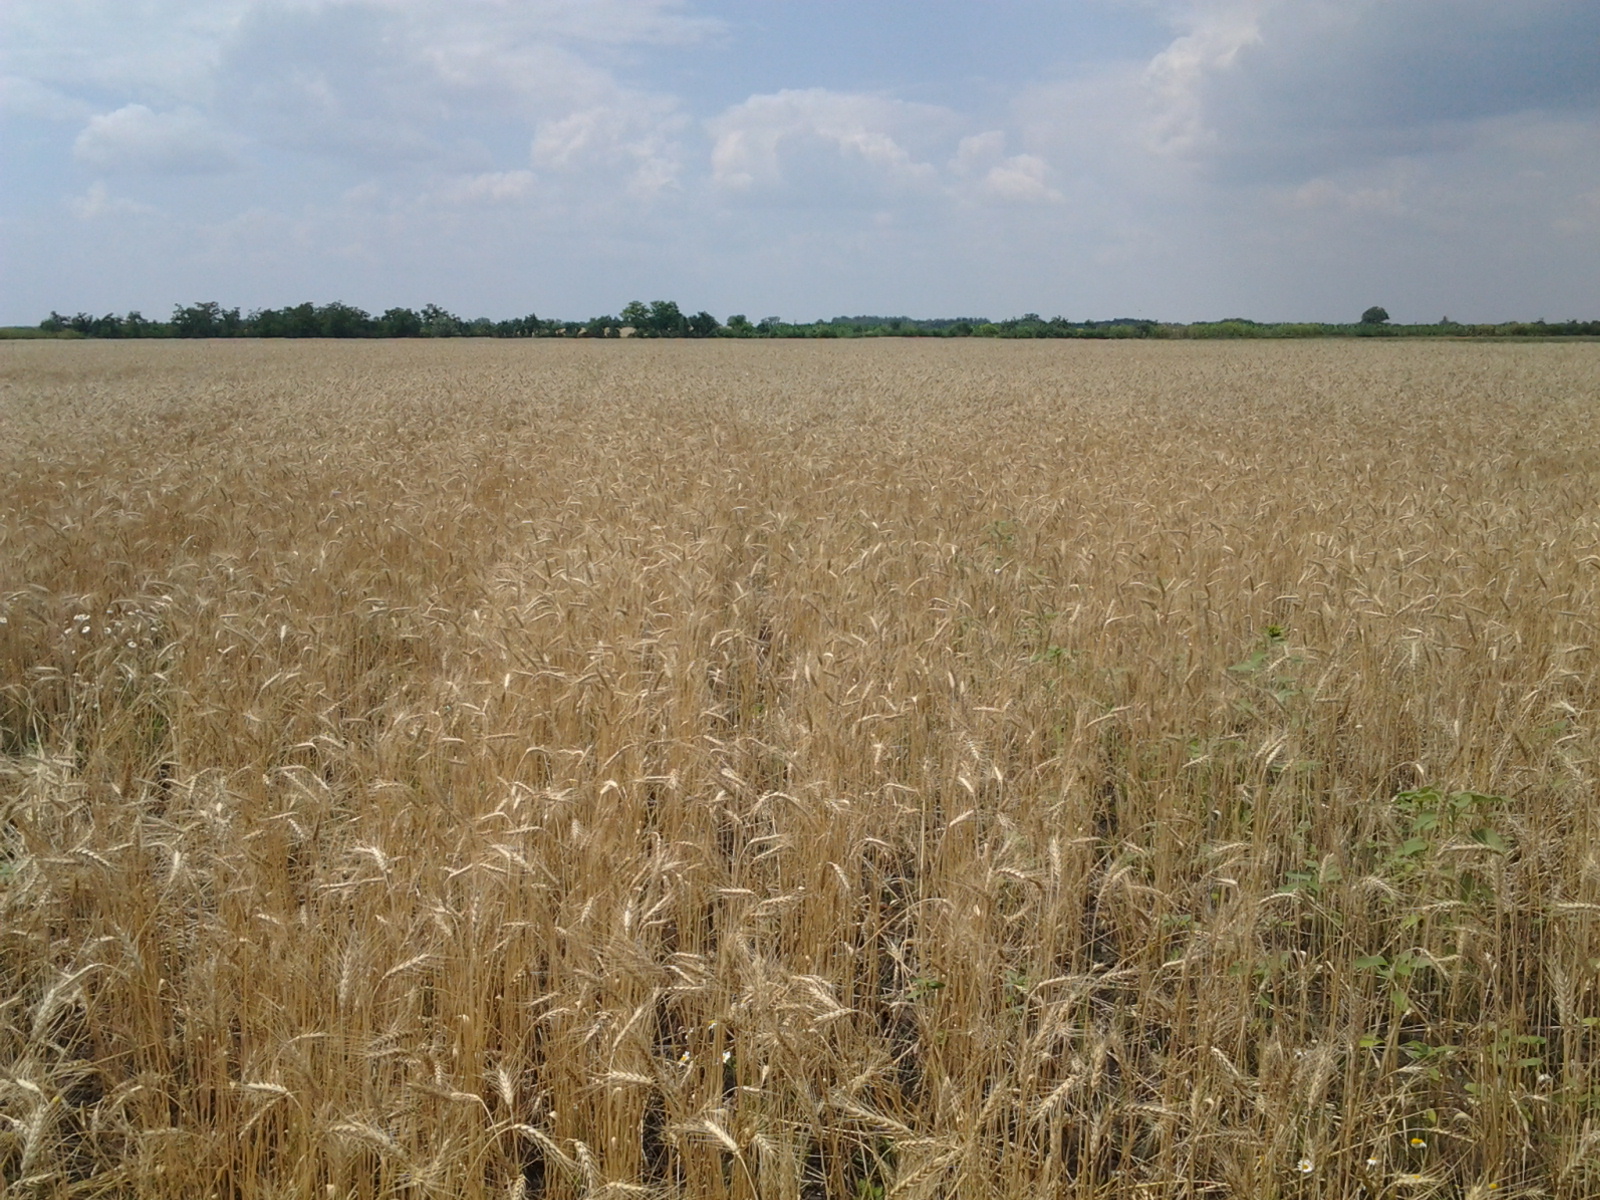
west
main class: Cropland
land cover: Triticale
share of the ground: > 75 %
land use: Agriculture (excluding fallow land and kitchen gardens)
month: June
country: HU
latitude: 47.4385
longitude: 20.2247
